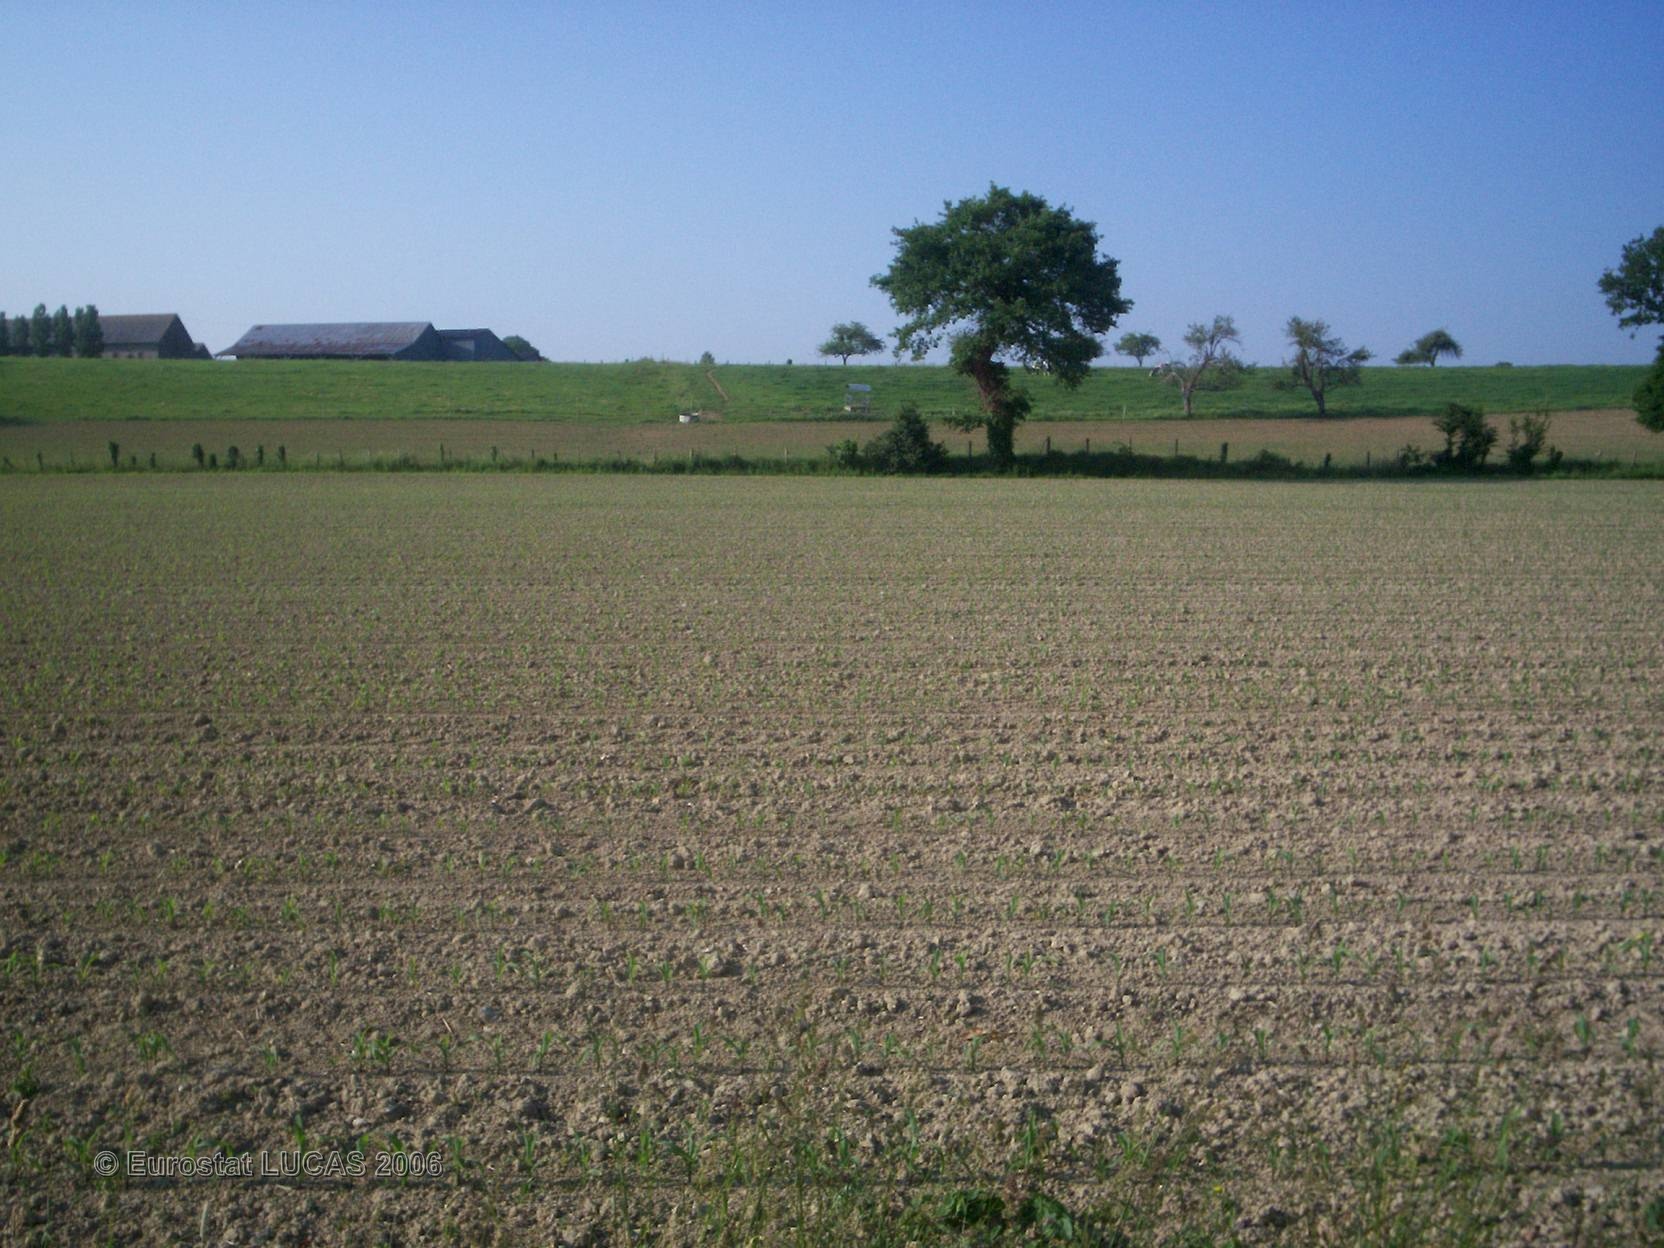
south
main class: Cropland
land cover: Maize
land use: Agriculture (excluding fallow land and kitchen gardens)
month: June
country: FR
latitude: 48.0277
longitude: -1.5923
